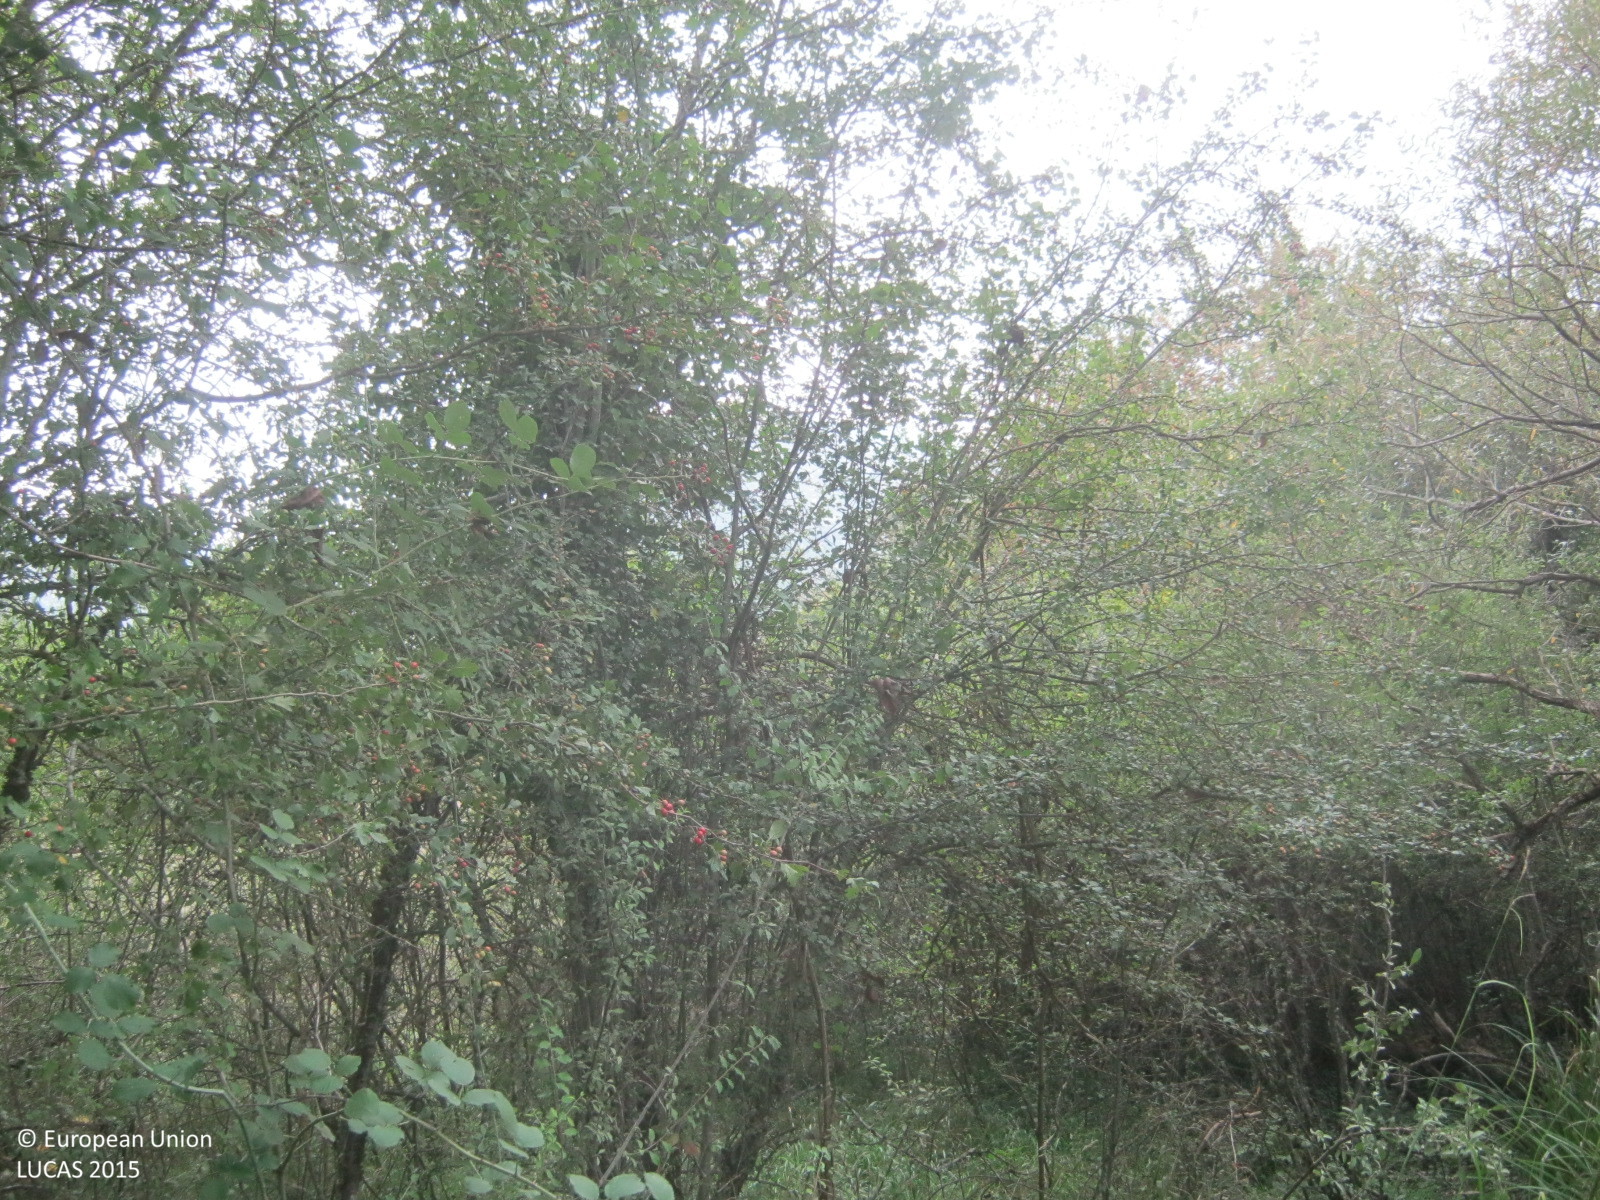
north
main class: Woodland
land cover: Broadleaved woodland
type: thermophilous deciduous forest
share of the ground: 50 - 75 %
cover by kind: broadleaved forest trees 70 %, herbaceous plants 30 %
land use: Semi-natural and natural areas not in use
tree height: > 5 m
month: September
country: GR
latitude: 37.8878
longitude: 22.0976
